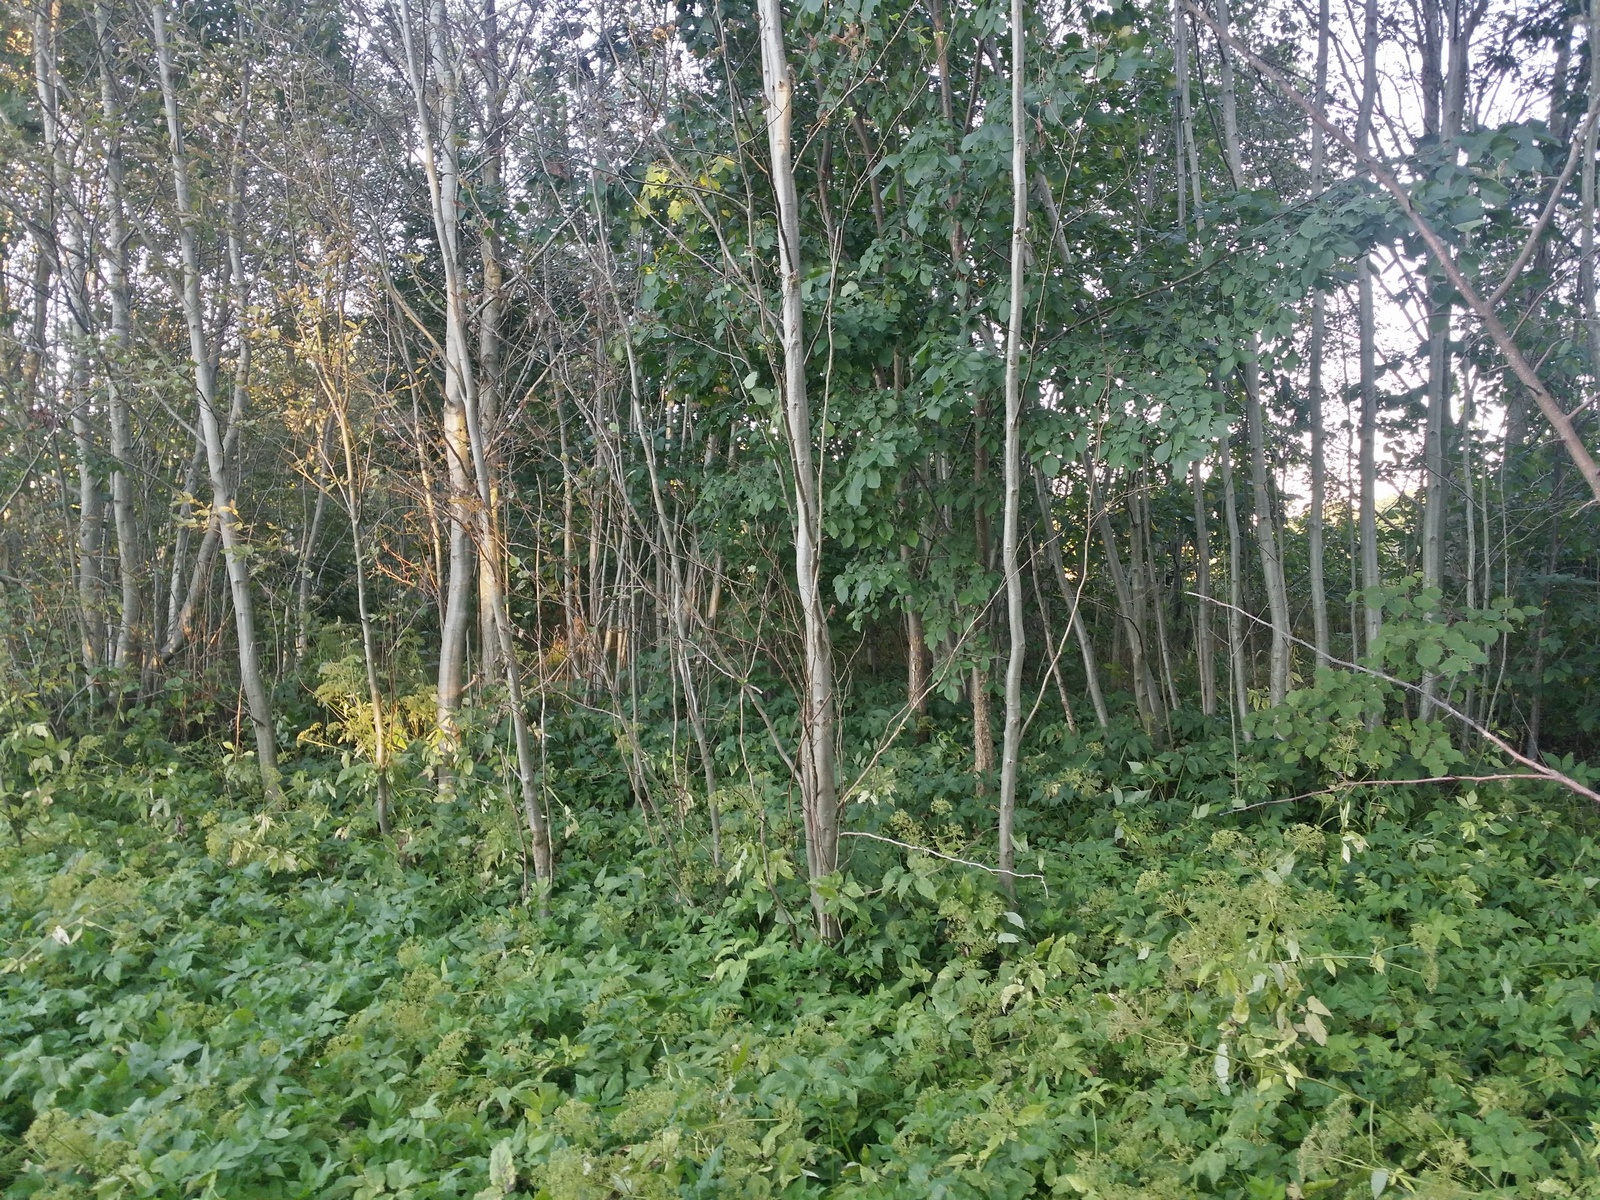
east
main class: Grassland
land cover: Spontaneously vegetated surfaces
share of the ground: > 75 %
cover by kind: herbaceous plants 95 %, shrubs 5 %
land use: Semi-natural and natural areas not in use
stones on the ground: < 10 %
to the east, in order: Spontaneously vegetated surfaces; Broadleaved woodland; Grassland without tree/shrub cover; Artificial constructions in urban areas; Grassland without tree/shrub cover; Single bushes/trees; Ditches and canals; Grass margins; Potatoes; Spontaneously vegetated surfaces; Ditches and canals; Shruby margins; Broadleaved woodland; Grassland without tree/shrub cover
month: August
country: LV
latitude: 57.1543
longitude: 26.7663
